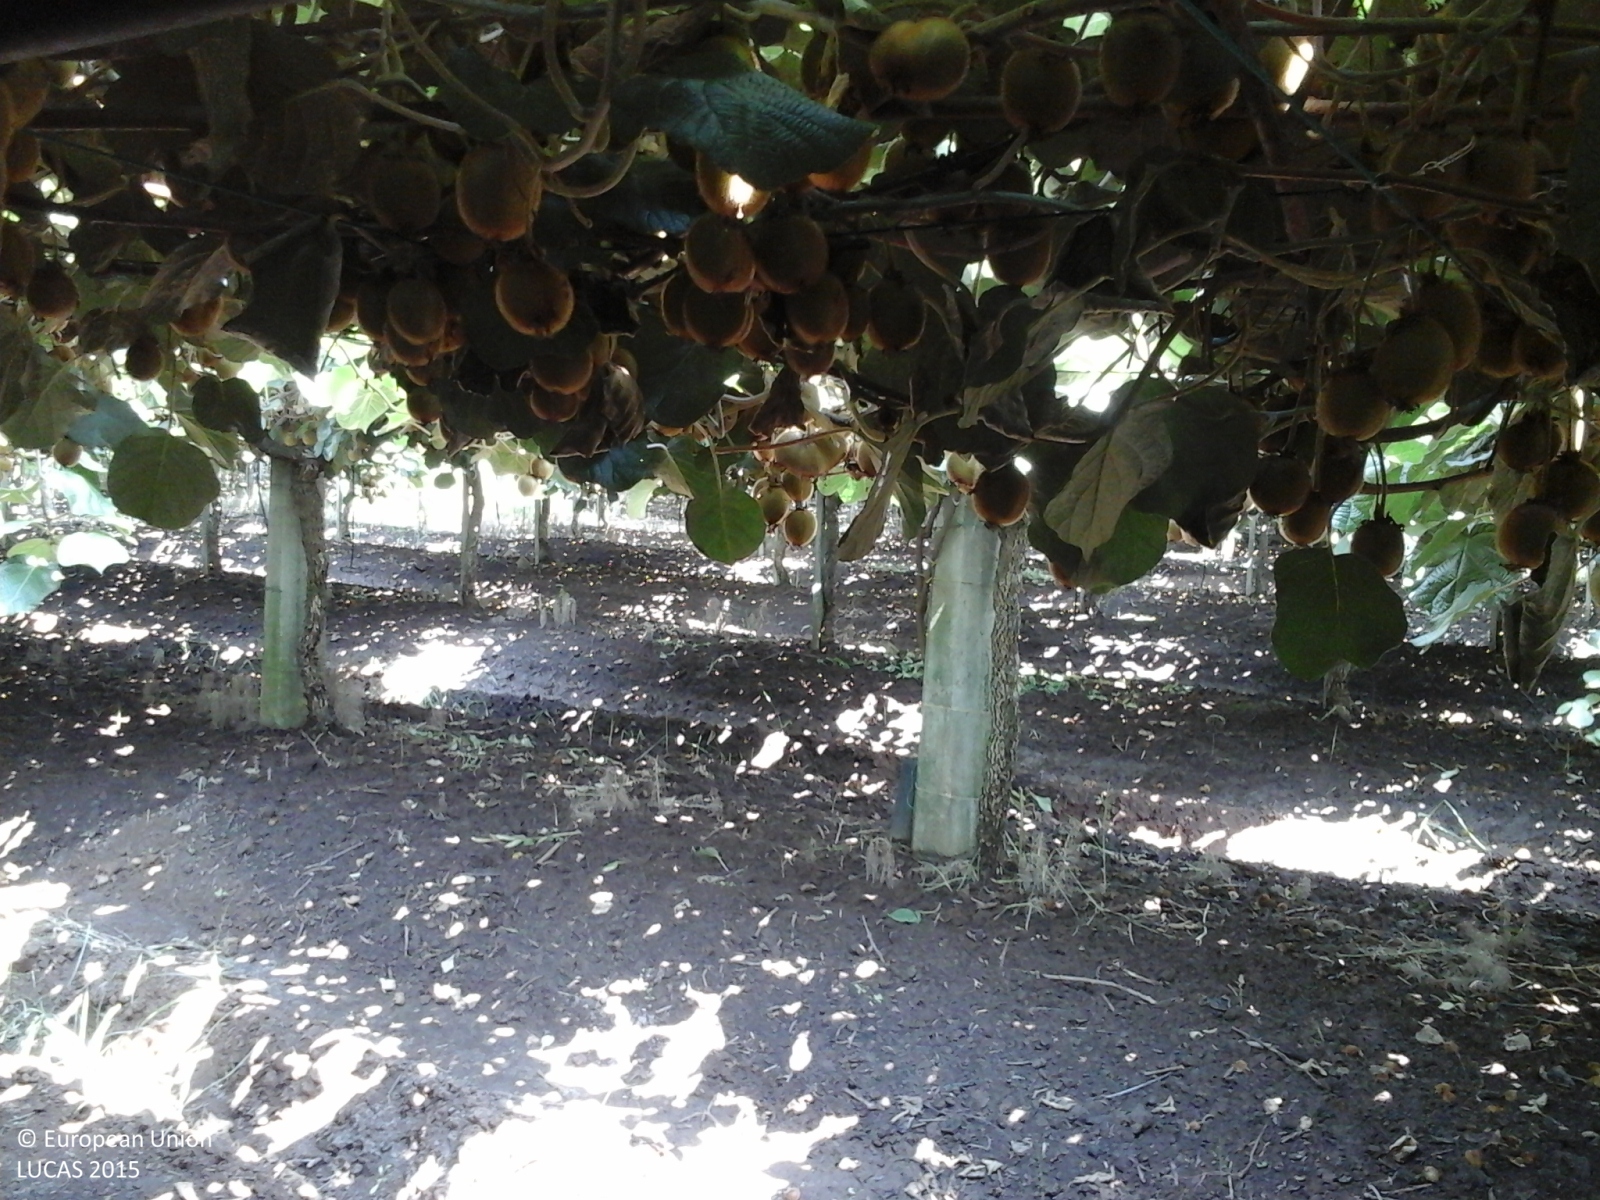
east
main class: Cropland
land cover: Other fruit trees and berries
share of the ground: > 75 %
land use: Agriculture (excluding fallow land and kitchen gardens)
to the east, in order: Other fruit trees and berries; Tracks; Other fruit trees and berries; Electric lines; Fences; Paved roads, cycling and walking lanes; Grass margins; Fences; Other bare soil; Broadleaved woodland; Ditches and canals; Tracks; Other fruit trees and berries
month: July
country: IT
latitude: 41.5819
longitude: 12.9033
